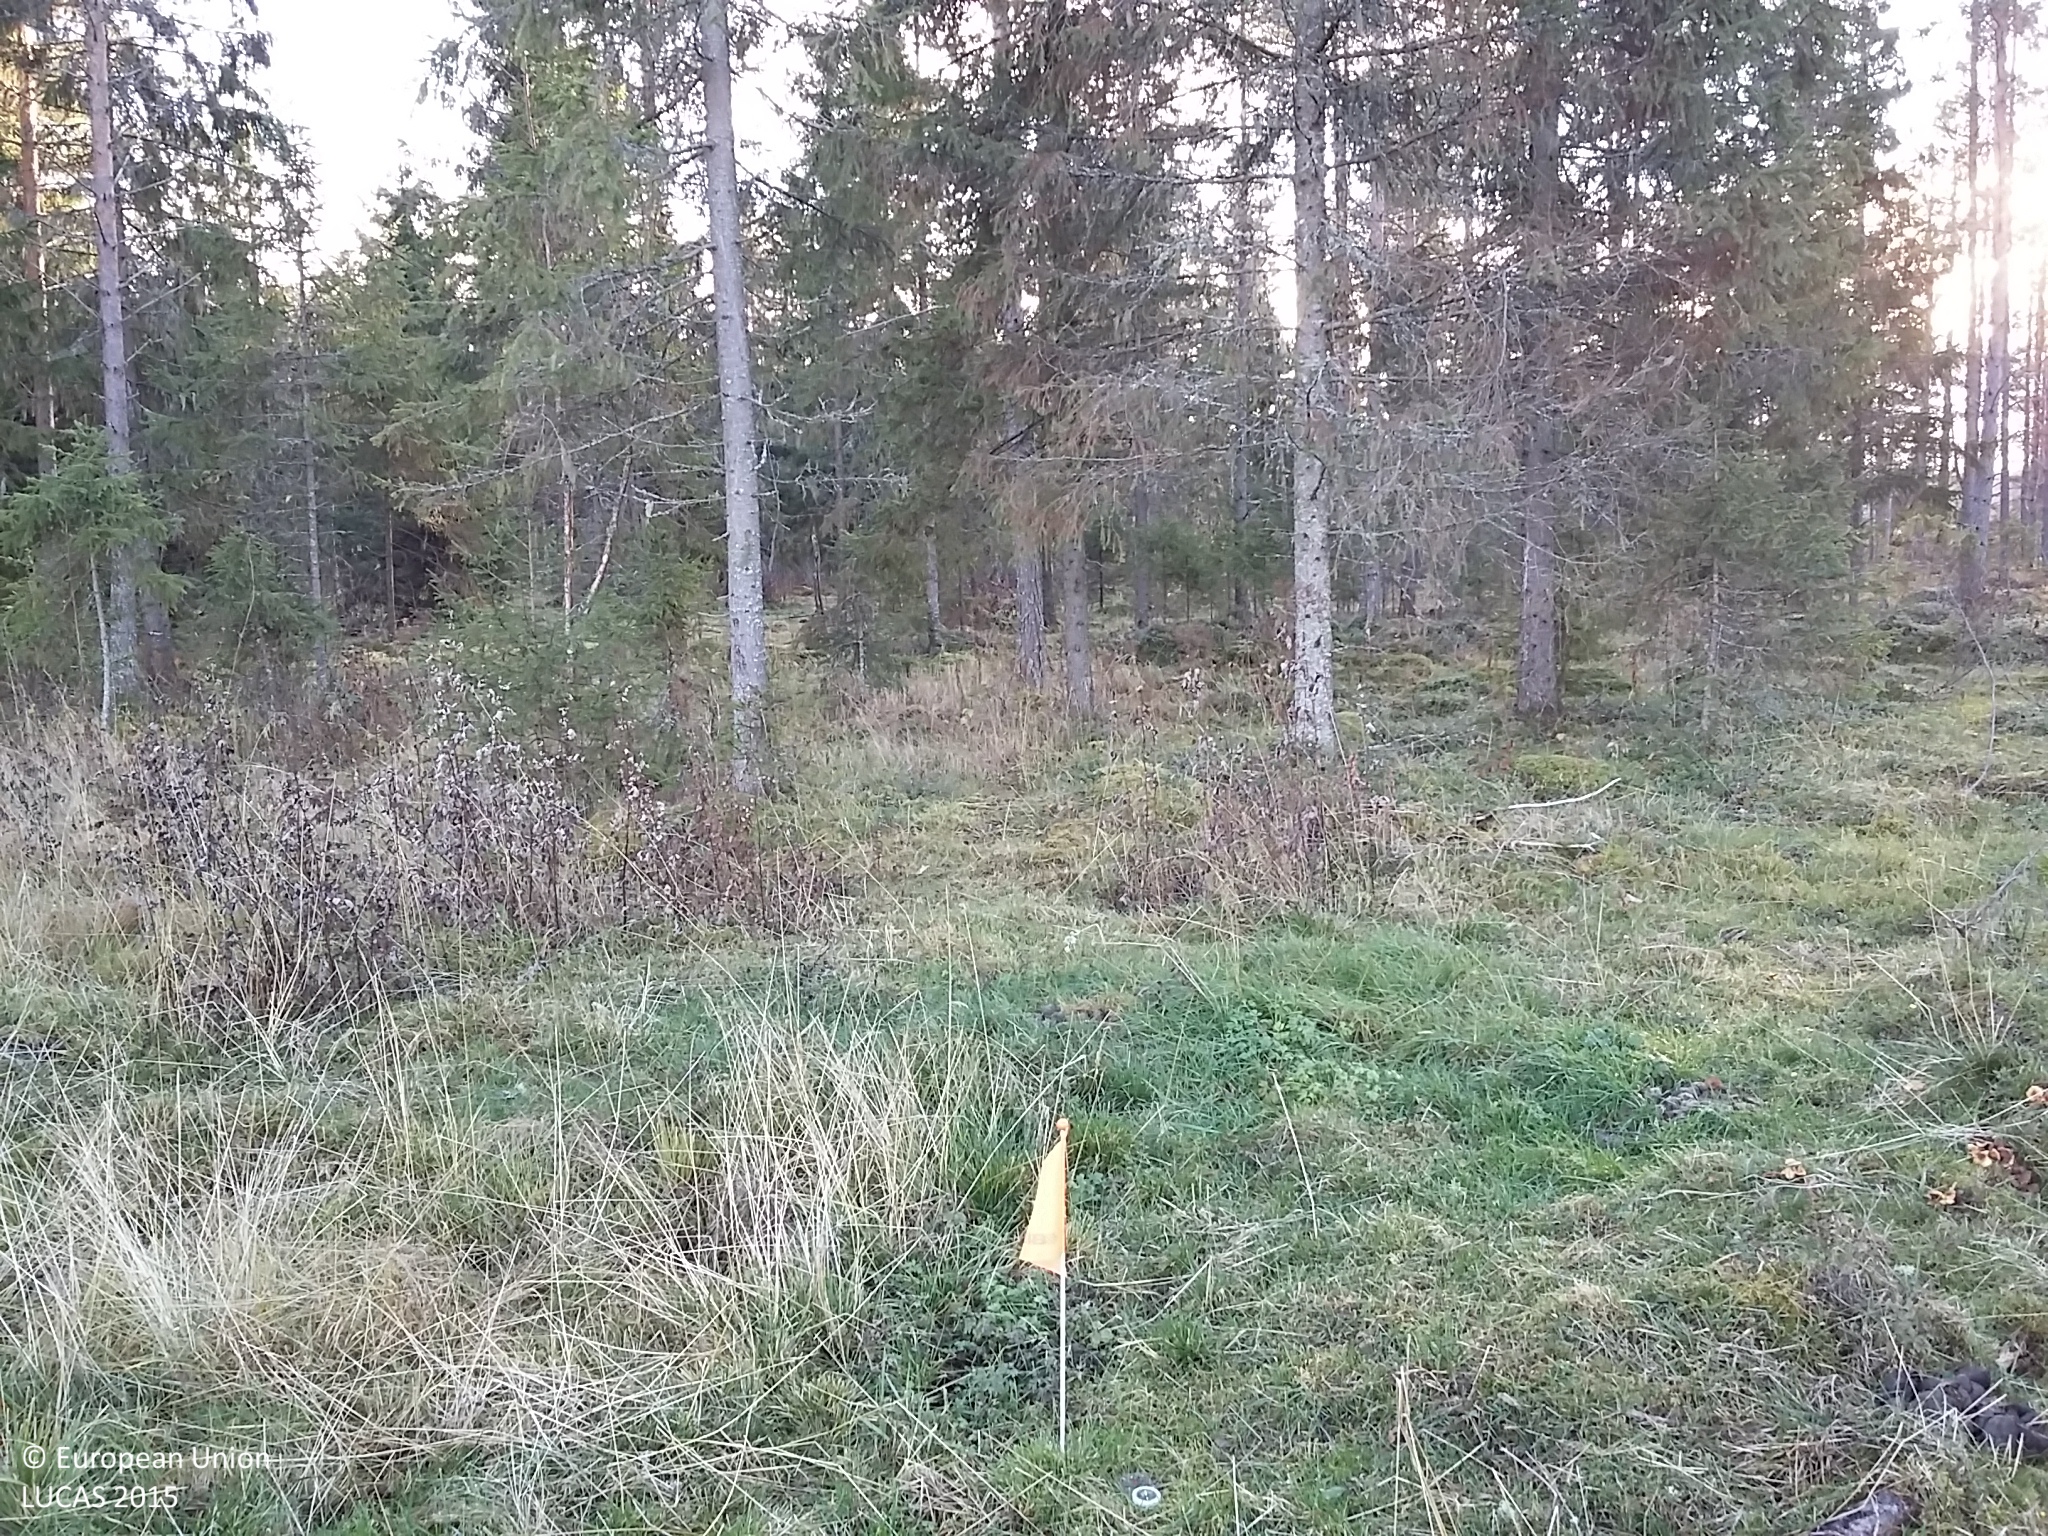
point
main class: Woodland
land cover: Spruce dominated coniferous woodland
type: boreal forest
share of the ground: 25 - 50 %
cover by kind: coniferous forest trees 40 %, shrubs 20 %, herbaceous plants 20 %, lichens and mosses 20 %
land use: Forestry
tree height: > 5 m
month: October
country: FI
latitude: 64.2089
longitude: 25.0597
